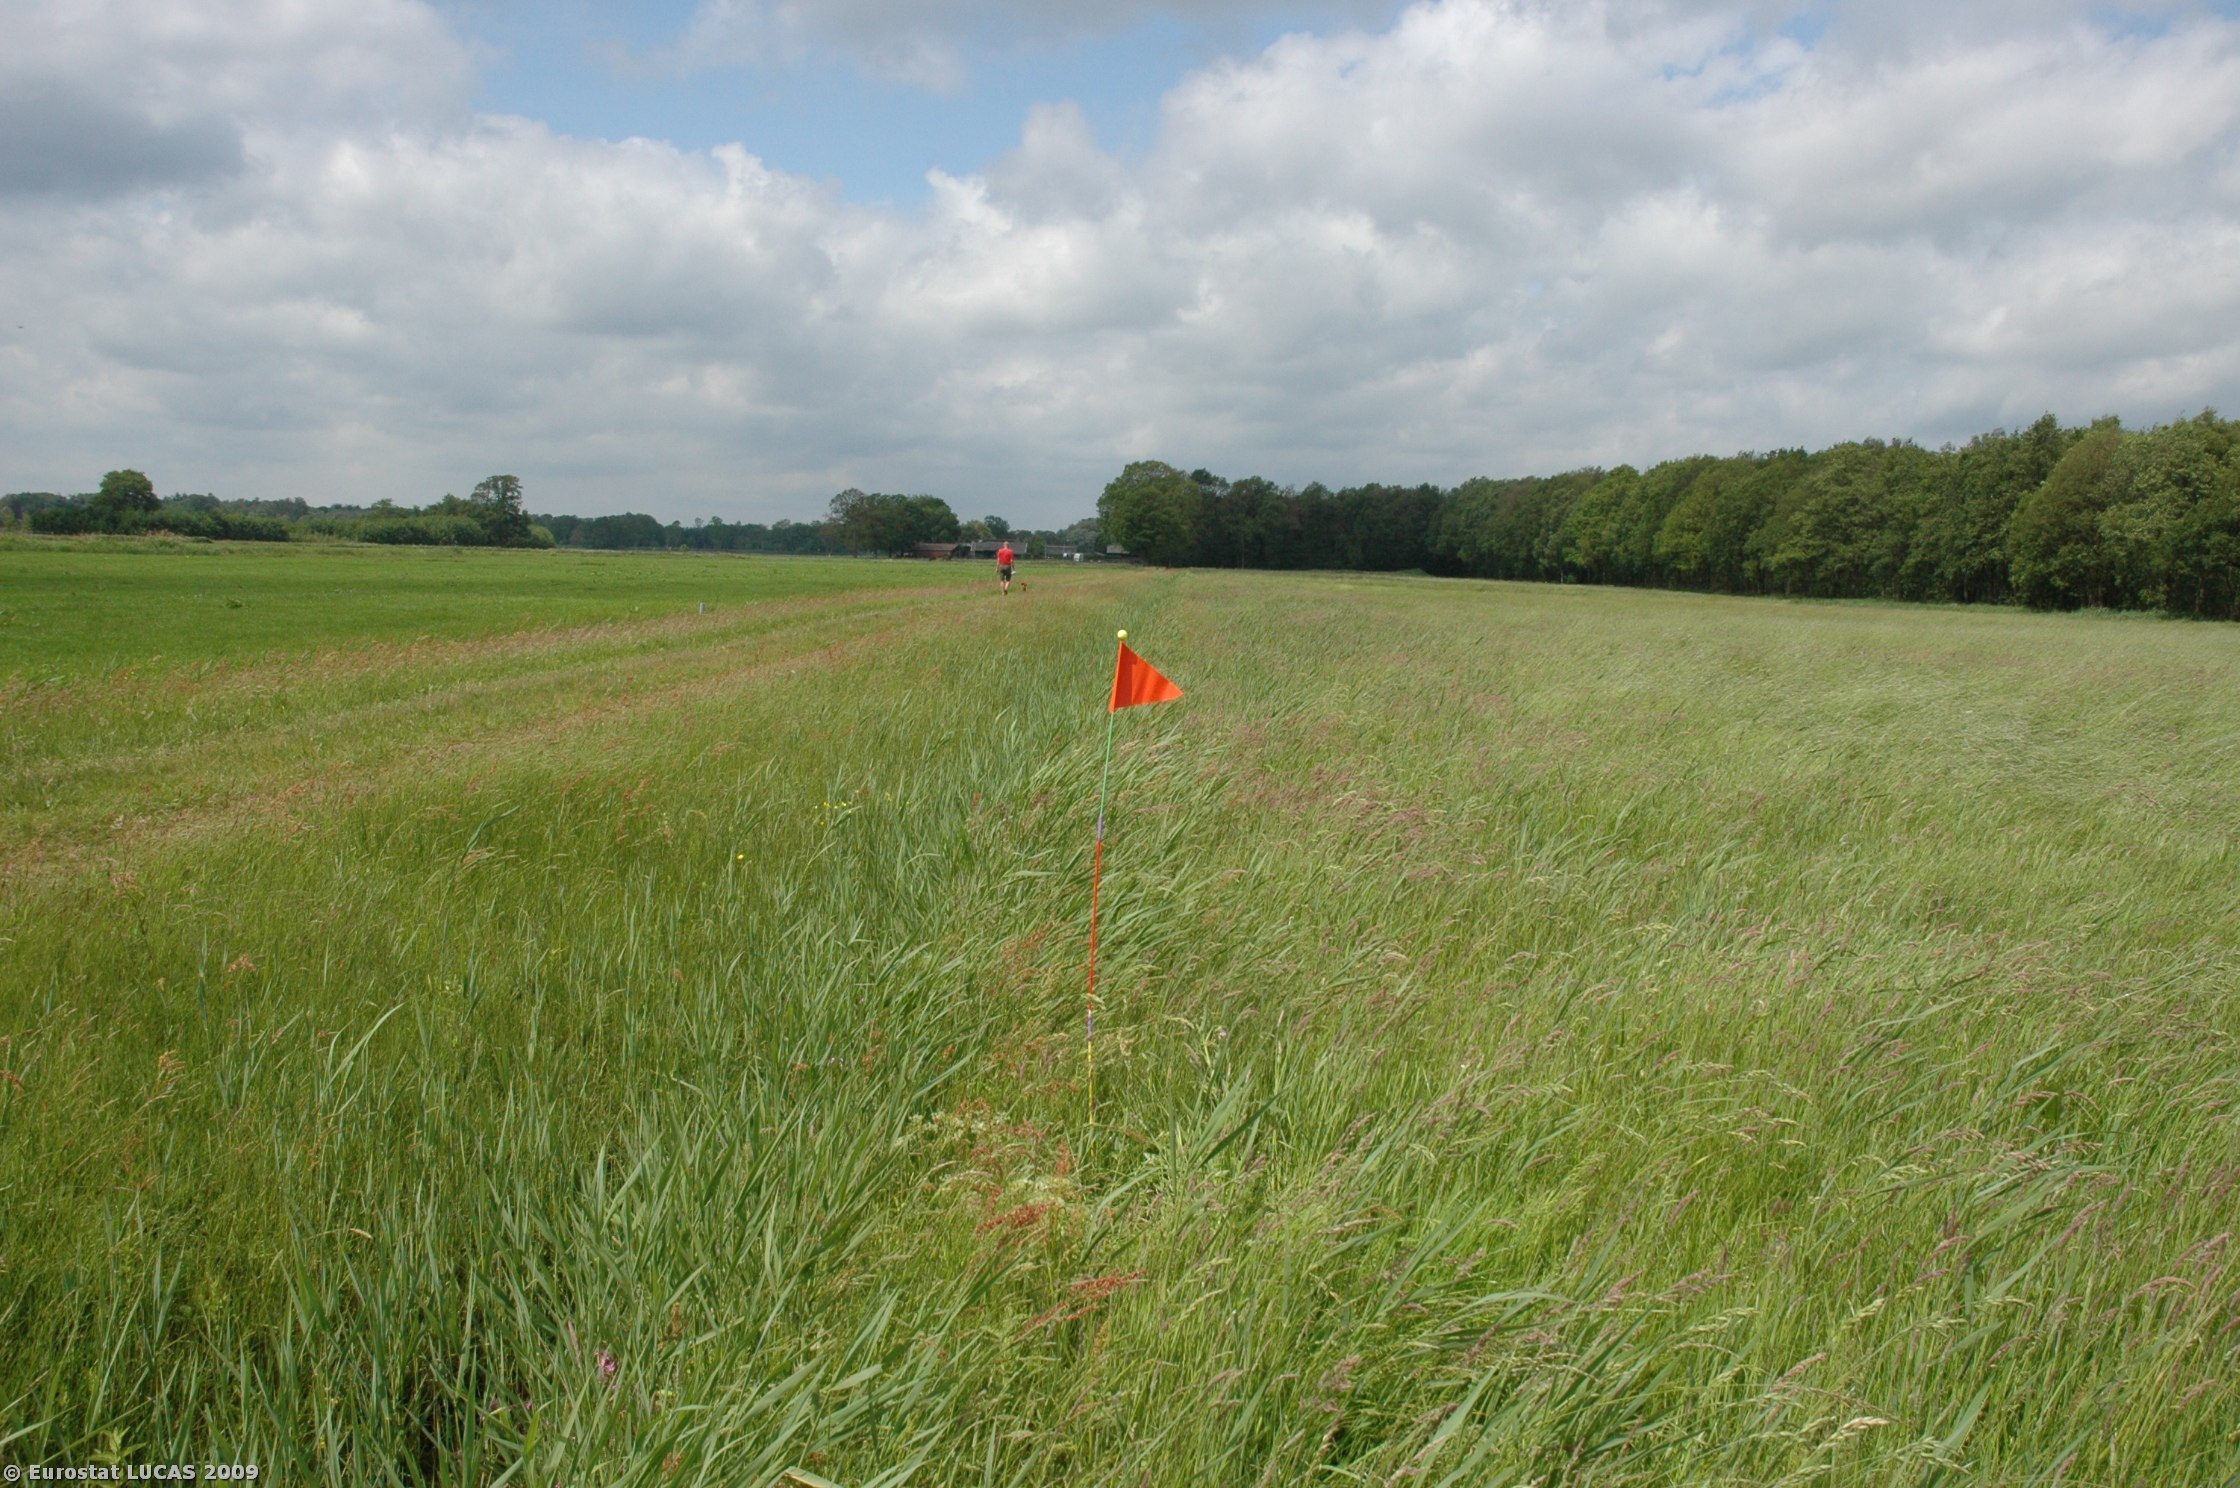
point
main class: Grassland
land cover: Grassland without tree/shrub cover
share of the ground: > 75 %
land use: Agriculture (excluding fallow land and kitchen gardens)
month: May
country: NL
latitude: 52.0796
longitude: 6.1032
